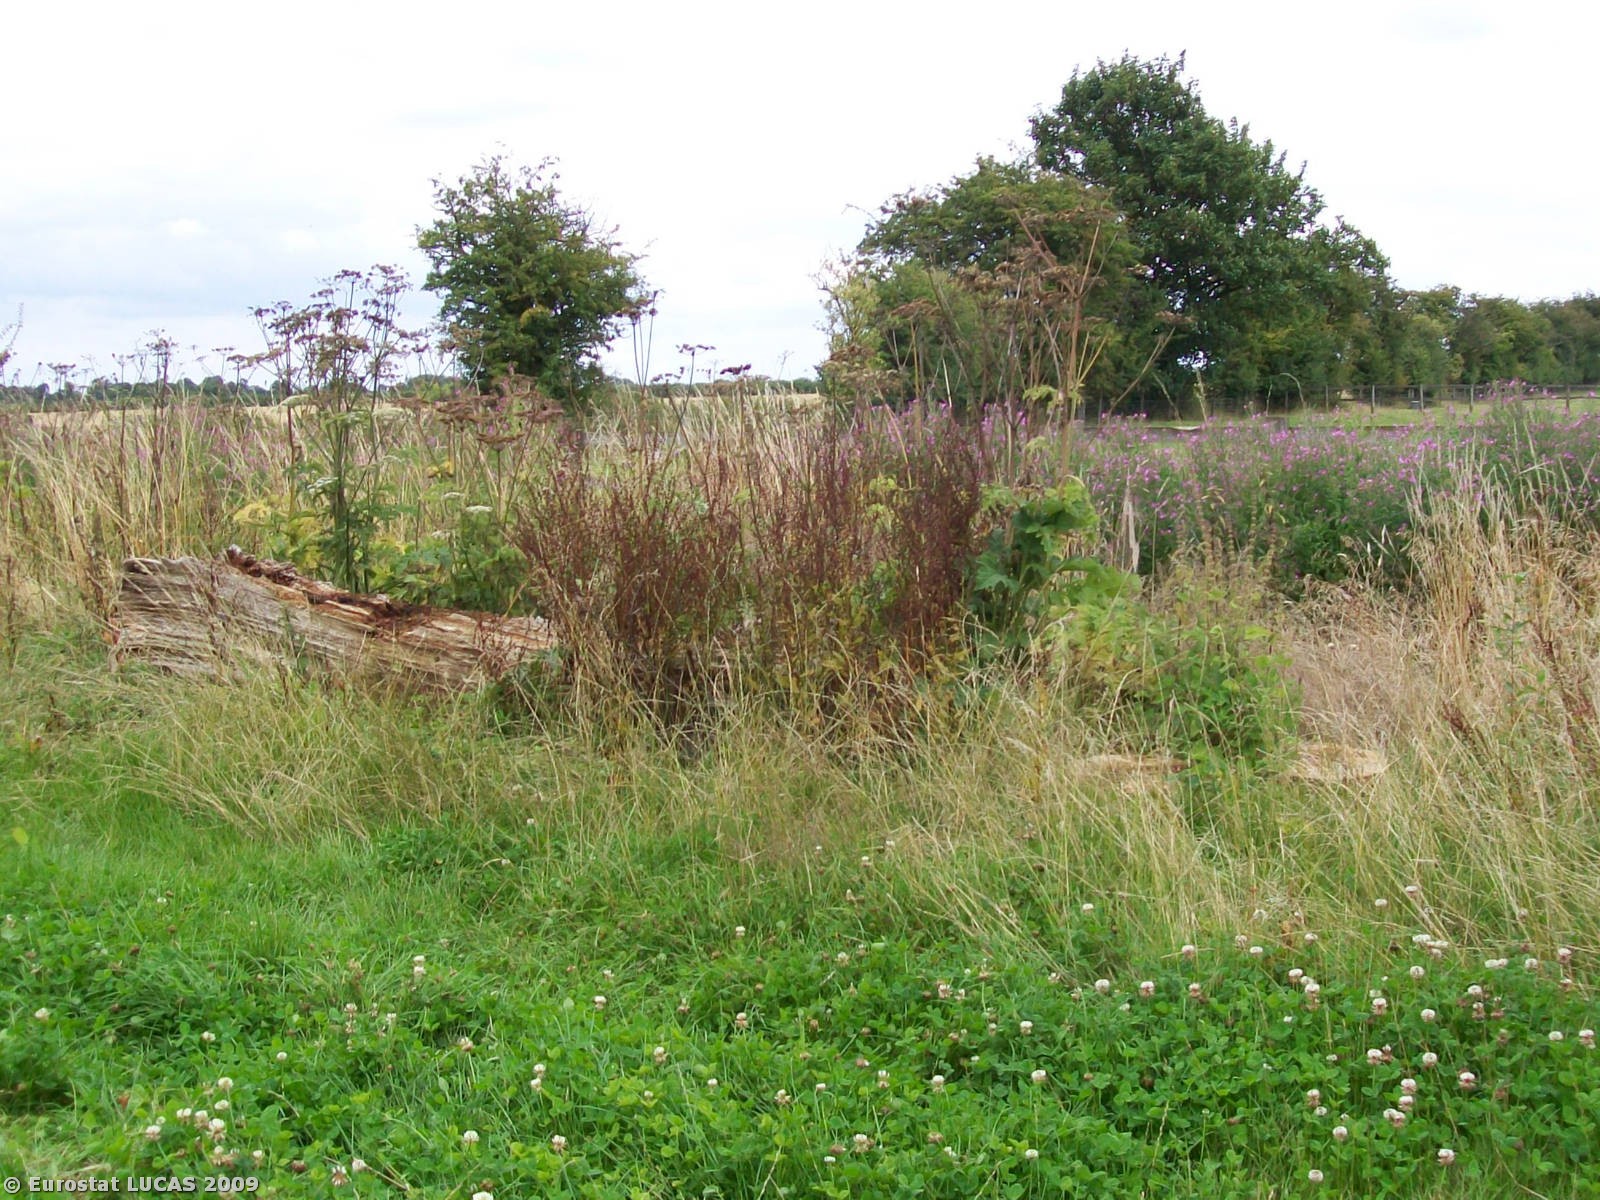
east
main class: Cropland
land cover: Common wheat
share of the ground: > 75 %
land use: Agriculture (excluding fallow land and kitchen gardens)
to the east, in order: Common wheat; Managed hedges; Grass margins; Common wheat
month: August
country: GB
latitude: 52.0192
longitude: -0.8993
